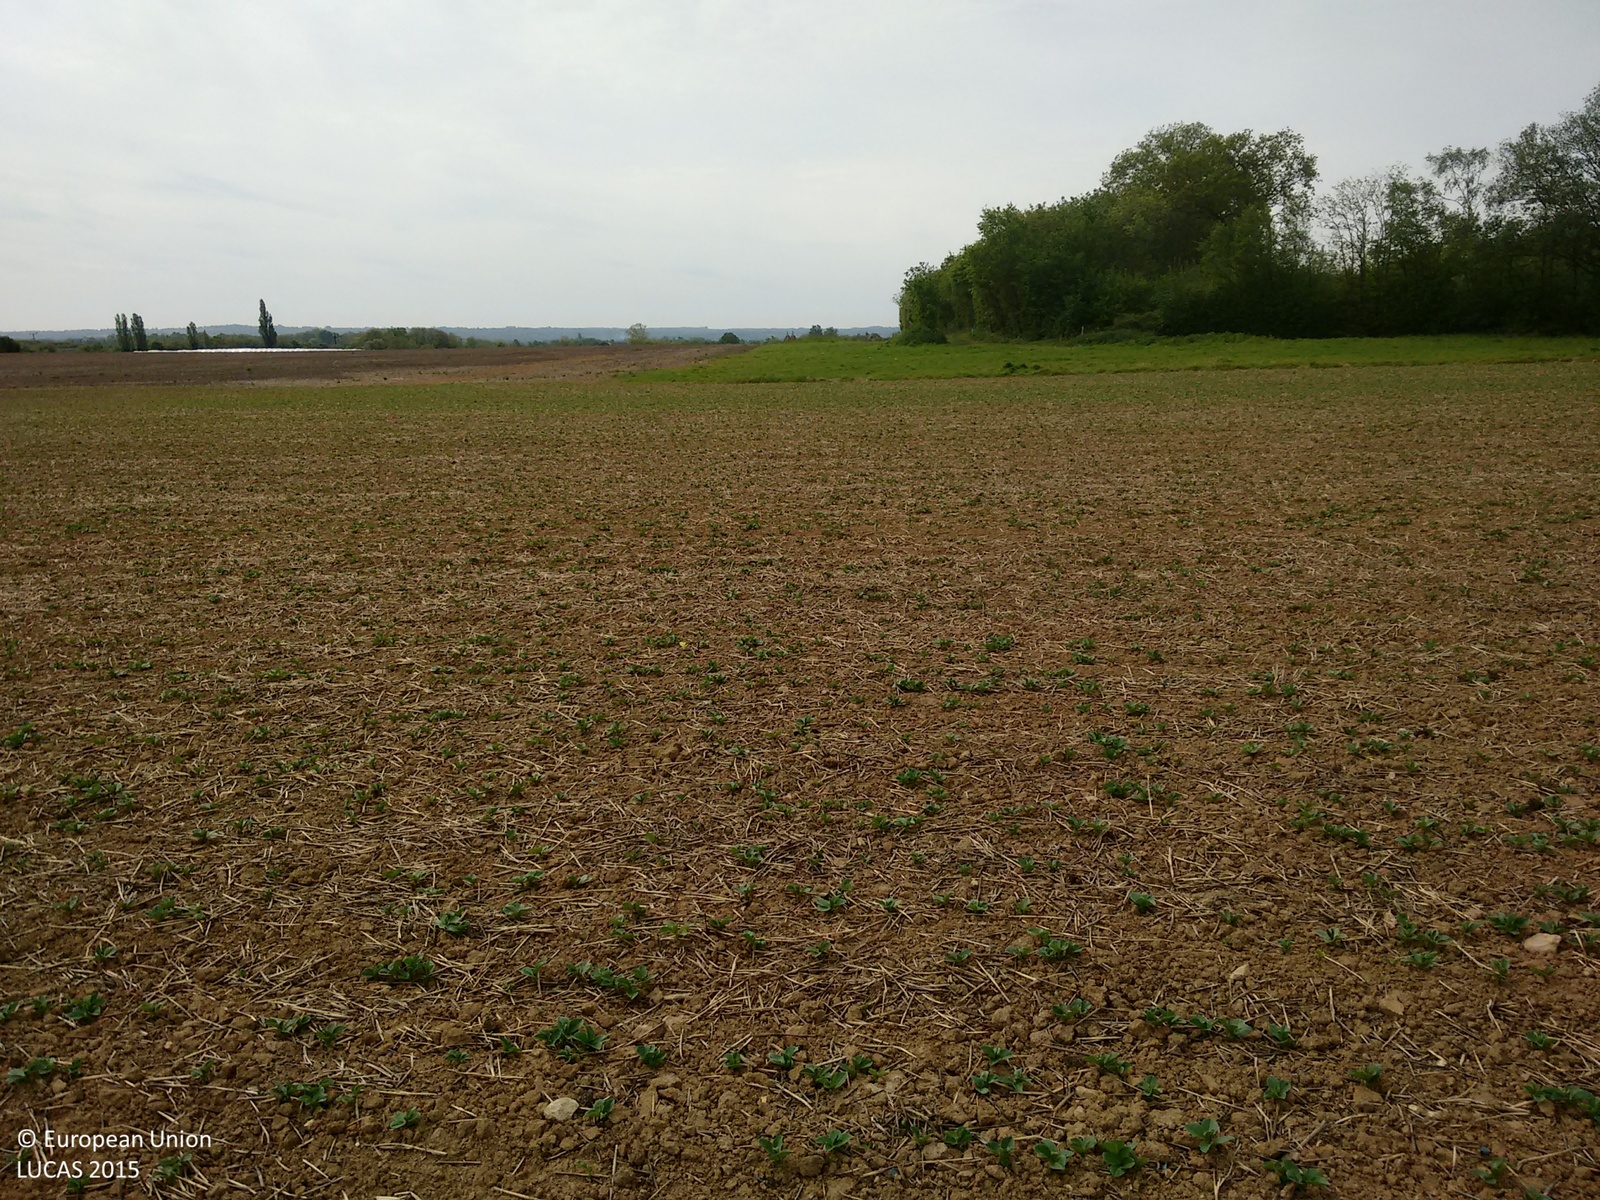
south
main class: Cropland
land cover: Dry pulses
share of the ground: 10 - 25 %
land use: Agriculture (excluding fallow land and kitchen gardens)
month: May
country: GB
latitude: 51.2418
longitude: 0.3591
